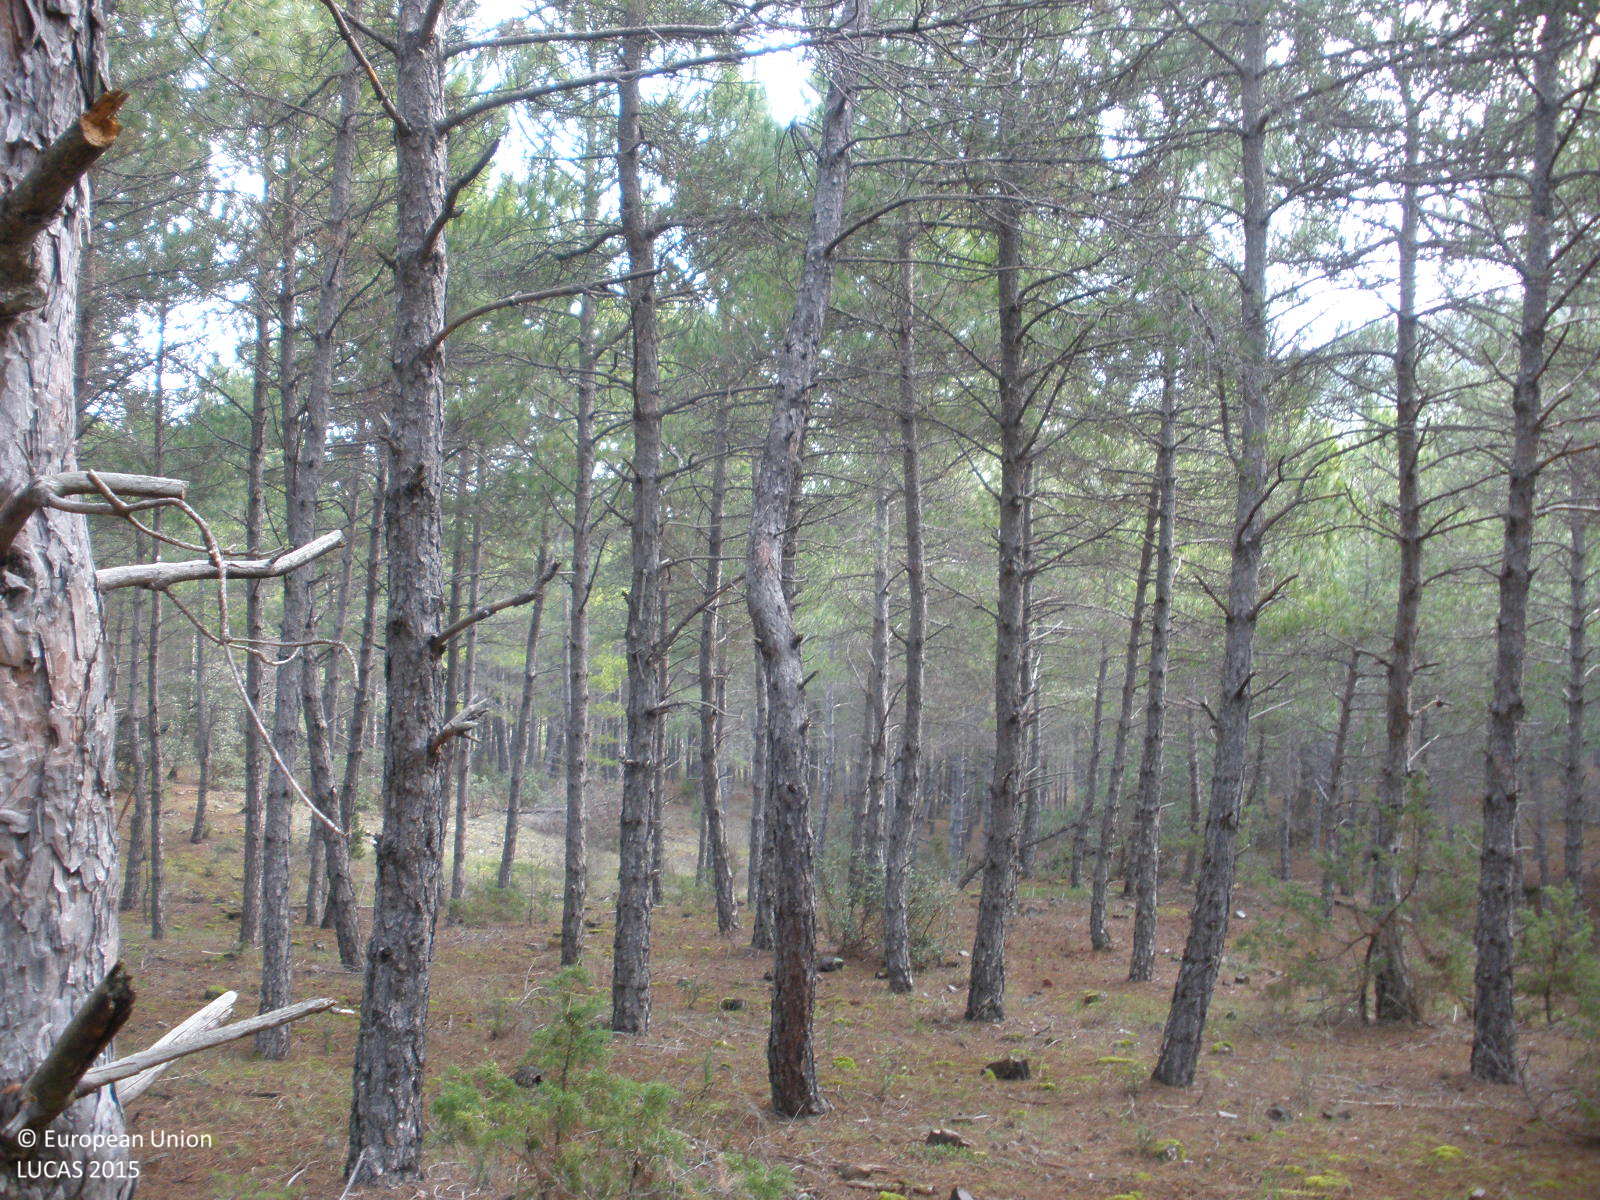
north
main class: Woodland
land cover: Pine dominated coniferous woodland
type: coniferous forest of the mediterranean region
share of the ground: > 75 %
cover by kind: coniferous forest trees 90 %, consolidated bare surface 10 %
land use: Forestry
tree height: < 5 m
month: April
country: ES
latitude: 41.1425
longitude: -1.1589
